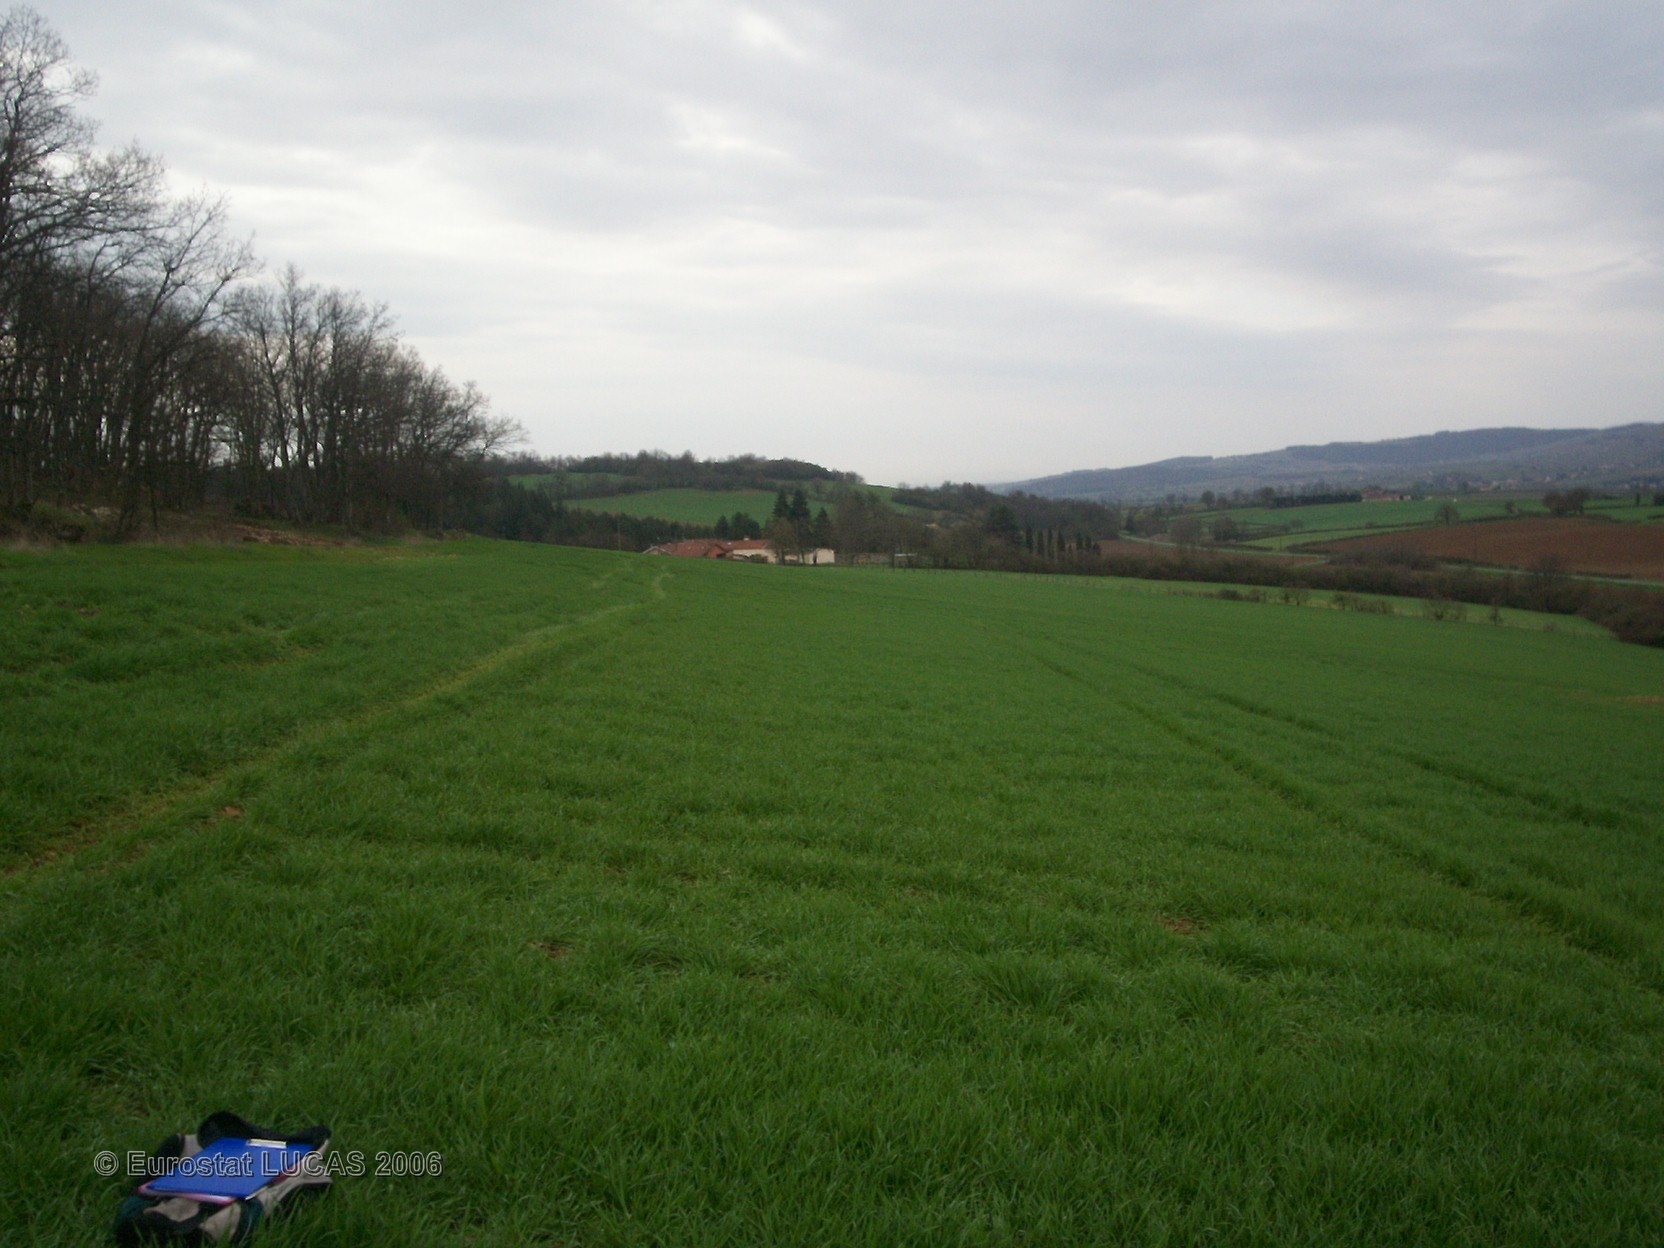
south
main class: Cropland
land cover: Barley
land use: Agriculture (excluding fallow land and kitchen gardens)
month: April
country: FR
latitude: 46.3494
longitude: 4.7653
